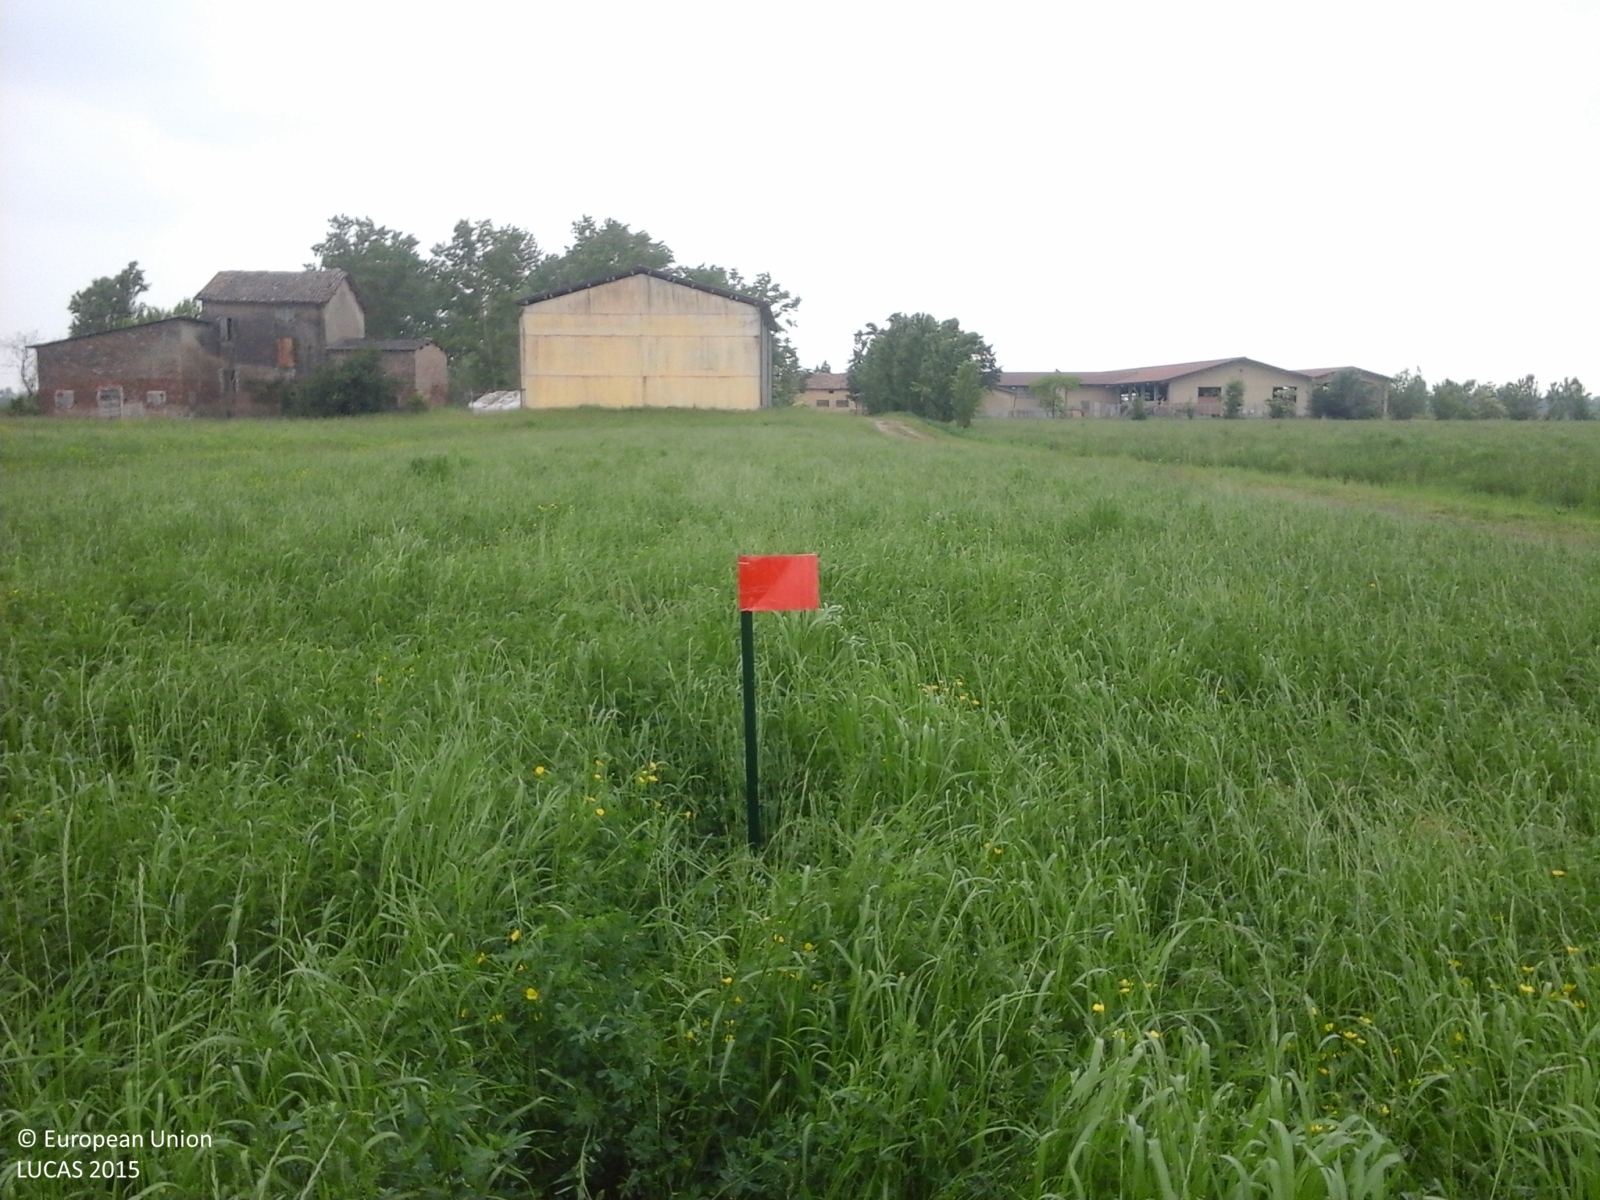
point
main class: Cropland
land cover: Lucerne
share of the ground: > 75 %
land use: Agriculture (excluding fallow land and kitchen gardens)
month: May
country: IT
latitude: 44.8889
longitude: 10.7455
